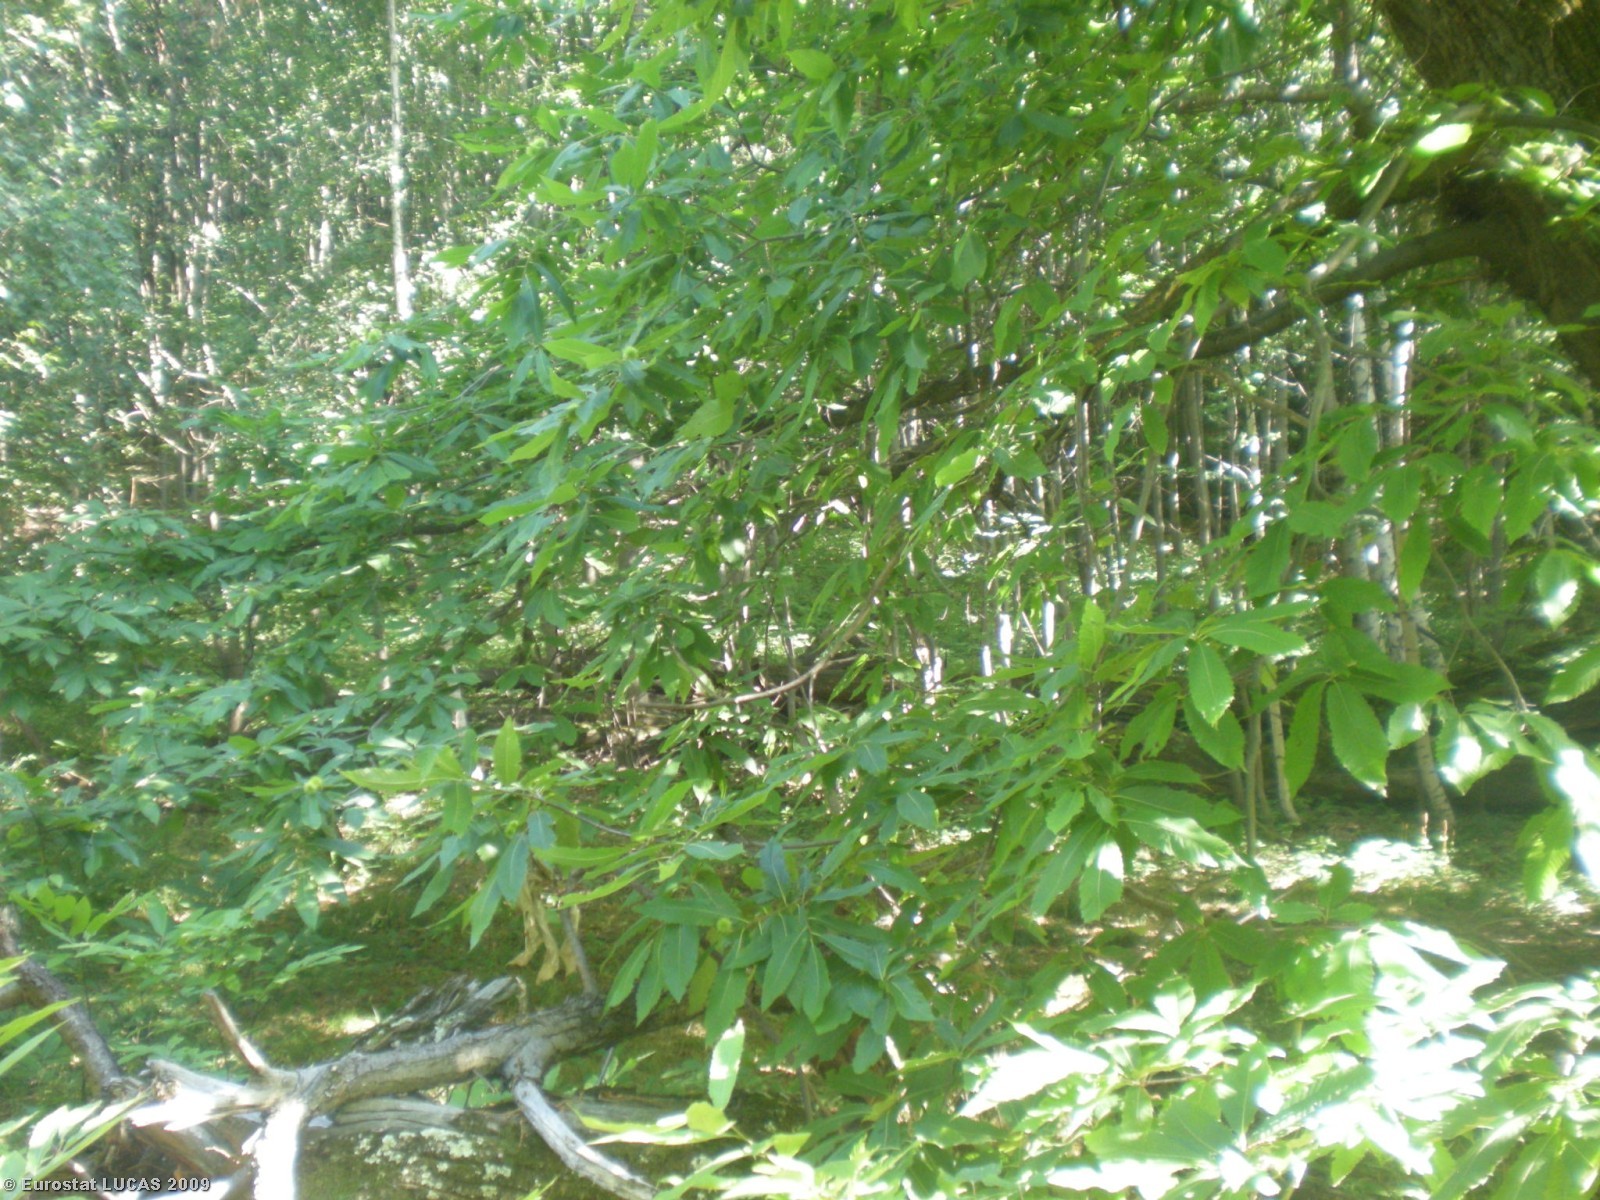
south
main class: Woodland
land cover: Broadleaved woodland
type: mesophytic deciduous forest
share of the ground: > 75 %
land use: Forestry
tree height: > 5 m
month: July
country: IT
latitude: 44.5519
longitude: 7.3743
